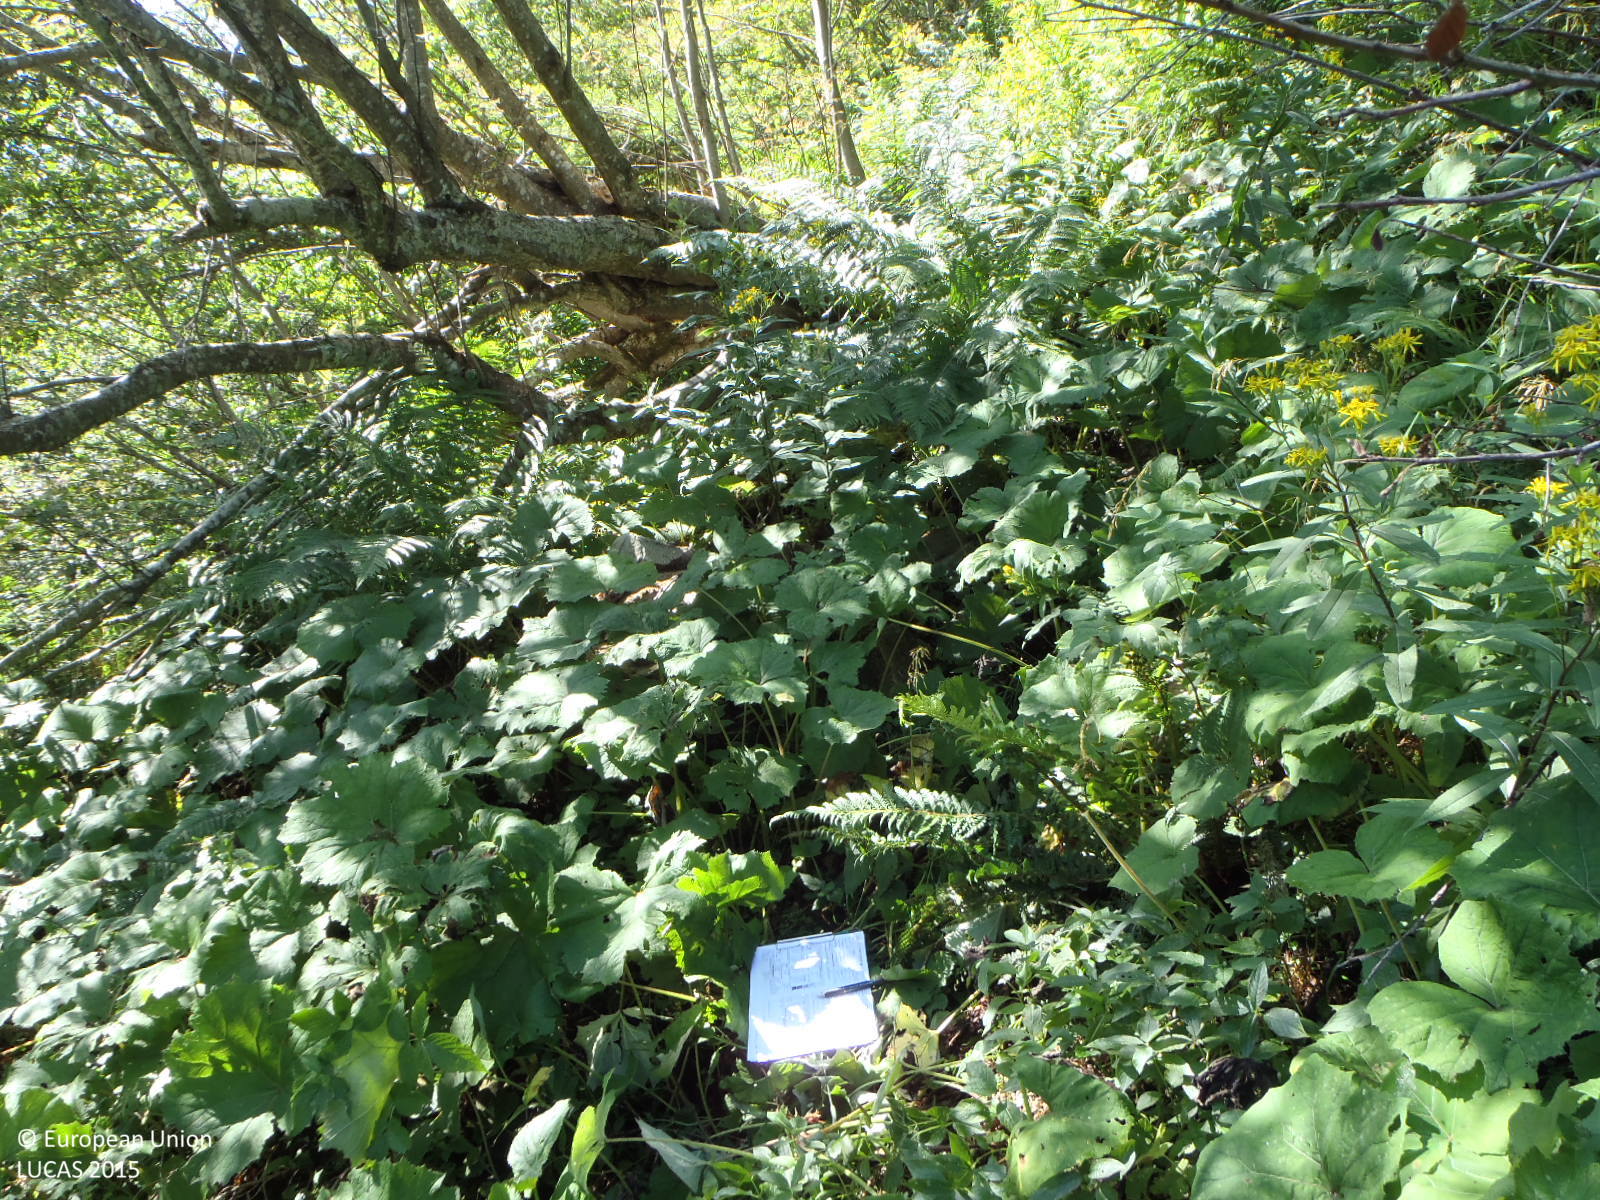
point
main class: Woodland
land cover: Broadleaved woodland
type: mountainous beech forest
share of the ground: > 75 %
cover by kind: broadleaved forest trees 70 %, herbaceous plants 20 %, shrubs 10 %
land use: Forestry
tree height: > 5 m
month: July
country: AT
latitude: 47.0921
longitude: 11.8294
